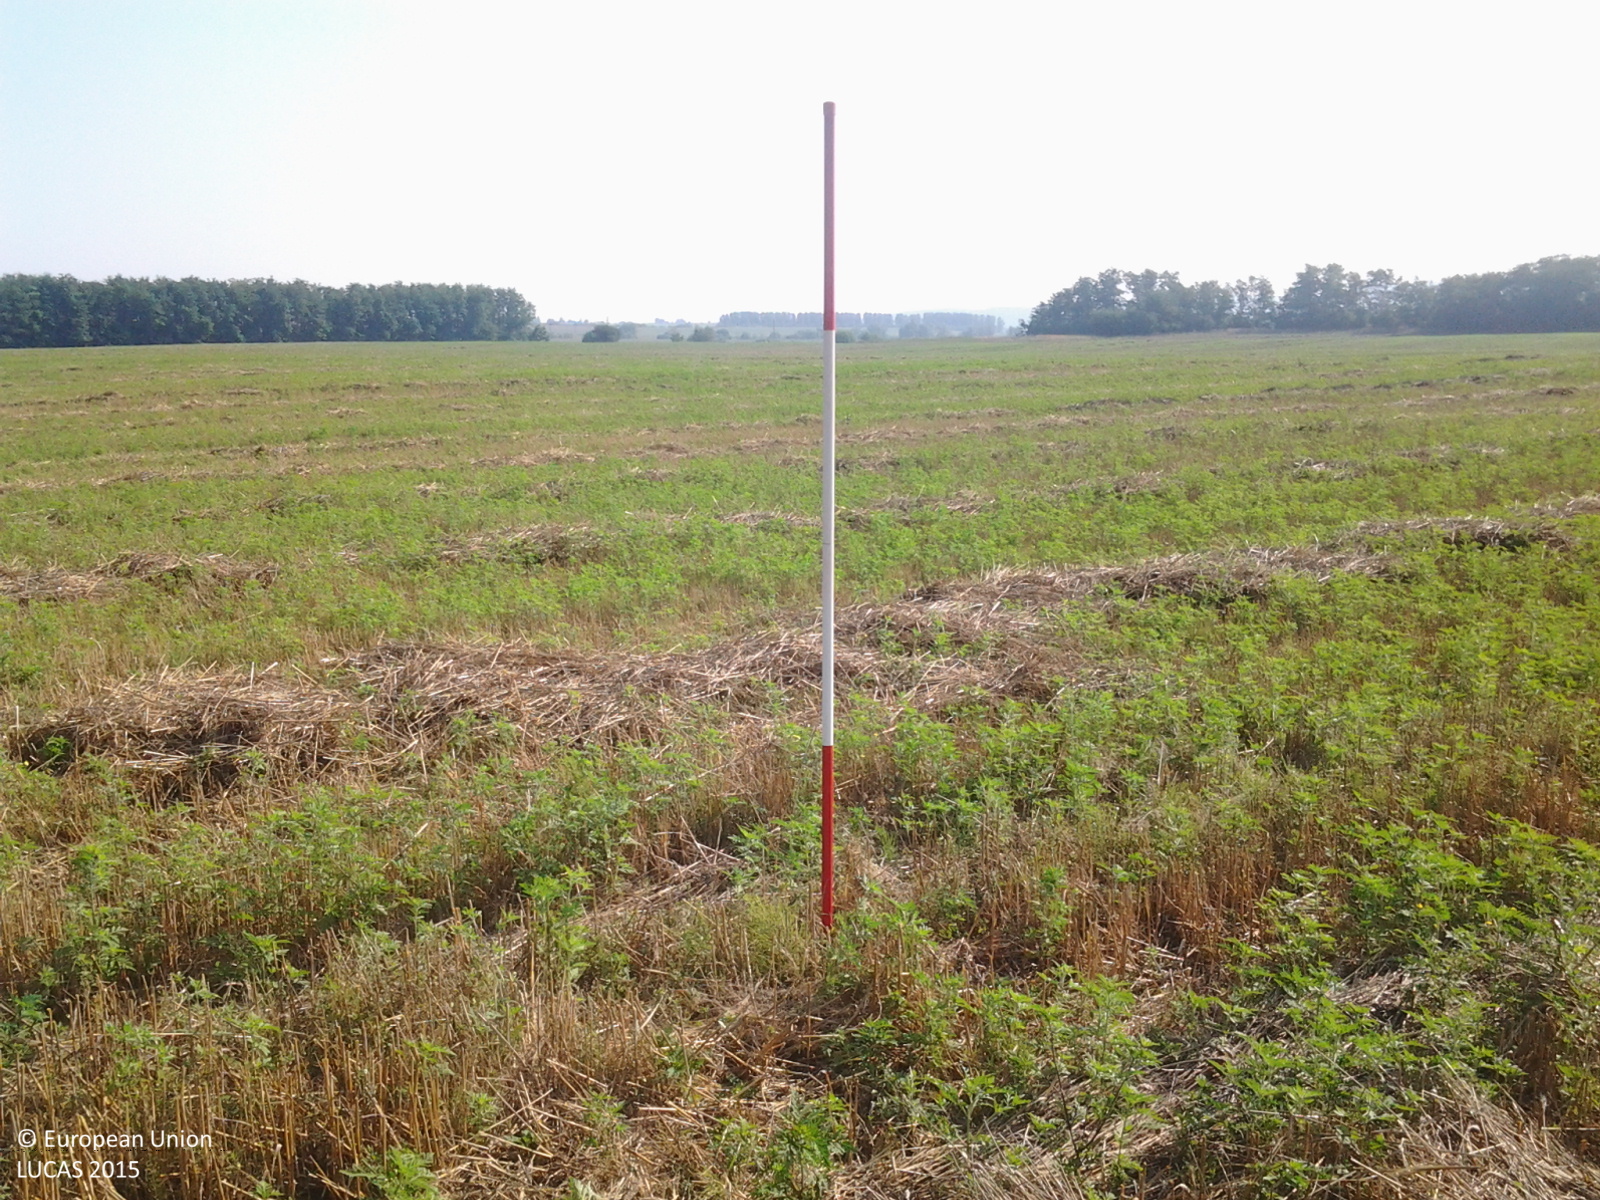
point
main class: Cropland
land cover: Durum wheat
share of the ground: 10 - 25 %
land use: Agriculture (excluding fallow land and kitchen gardens)
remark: Harvested field
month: August
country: HU
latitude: 46.3968
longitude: 18.2148
